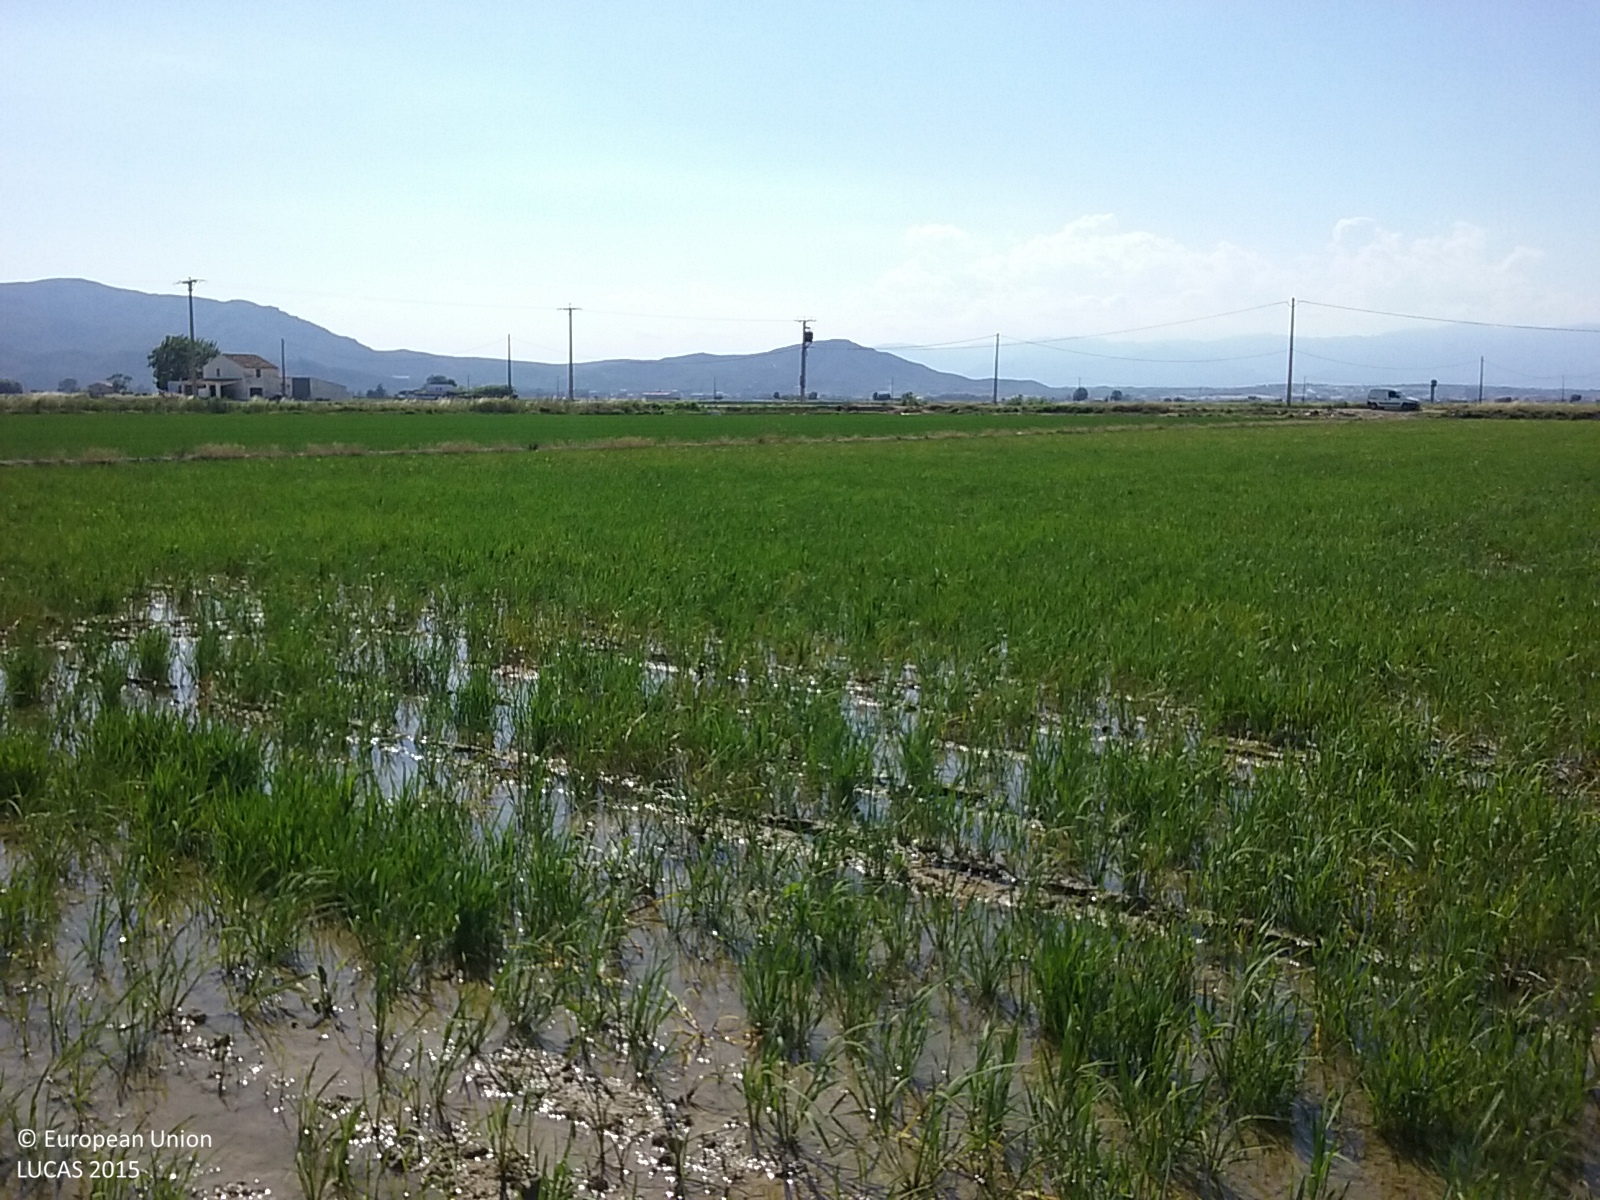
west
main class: Cropland
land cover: Rice
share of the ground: > 75 %
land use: Agriculture (excluding fallow land and kitchen gardens)
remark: Temporary flooded
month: June
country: ES
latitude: 40.6741
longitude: 0.6376
